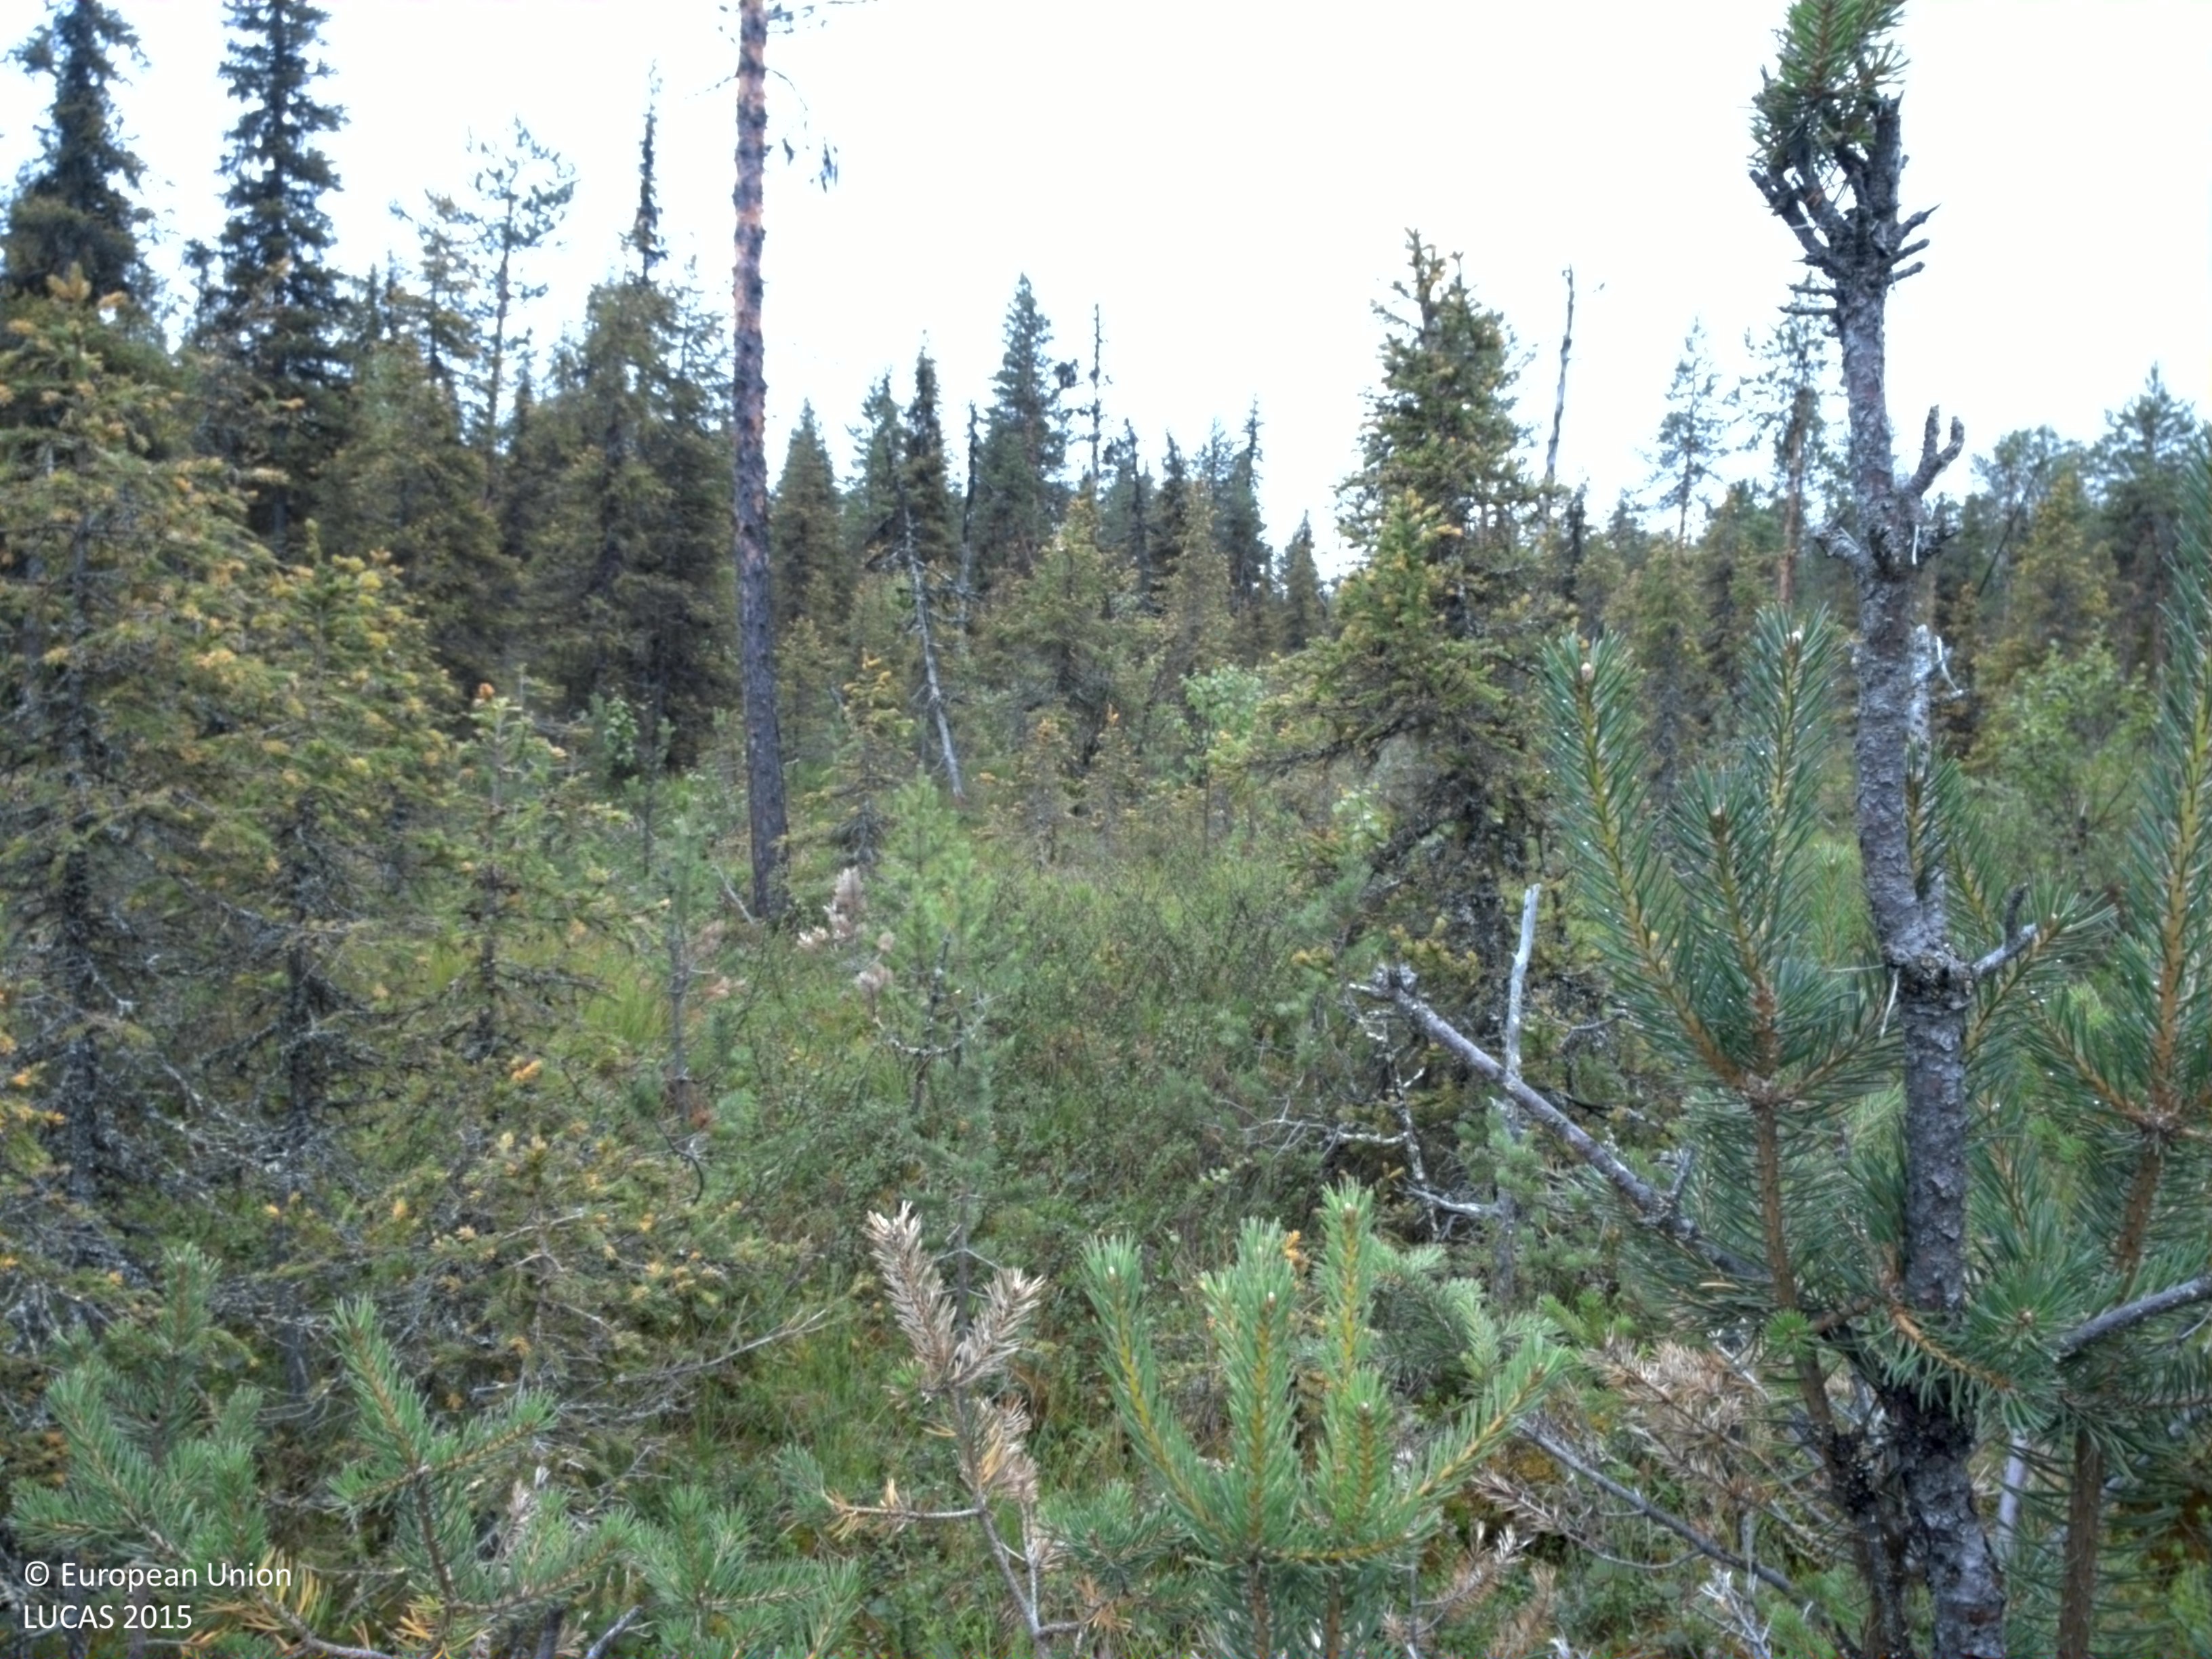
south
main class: Woodland
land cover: Spruce dominated coniferous woodland
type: boreal forest
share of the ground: 25 - 50 %
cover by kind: shrubs 75 %, coniferous forest trees 25 %
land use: Semi-natural and natural areas not in use
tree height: > 5 m
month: August
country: SE
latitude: 66.4742
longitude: 20.5761
